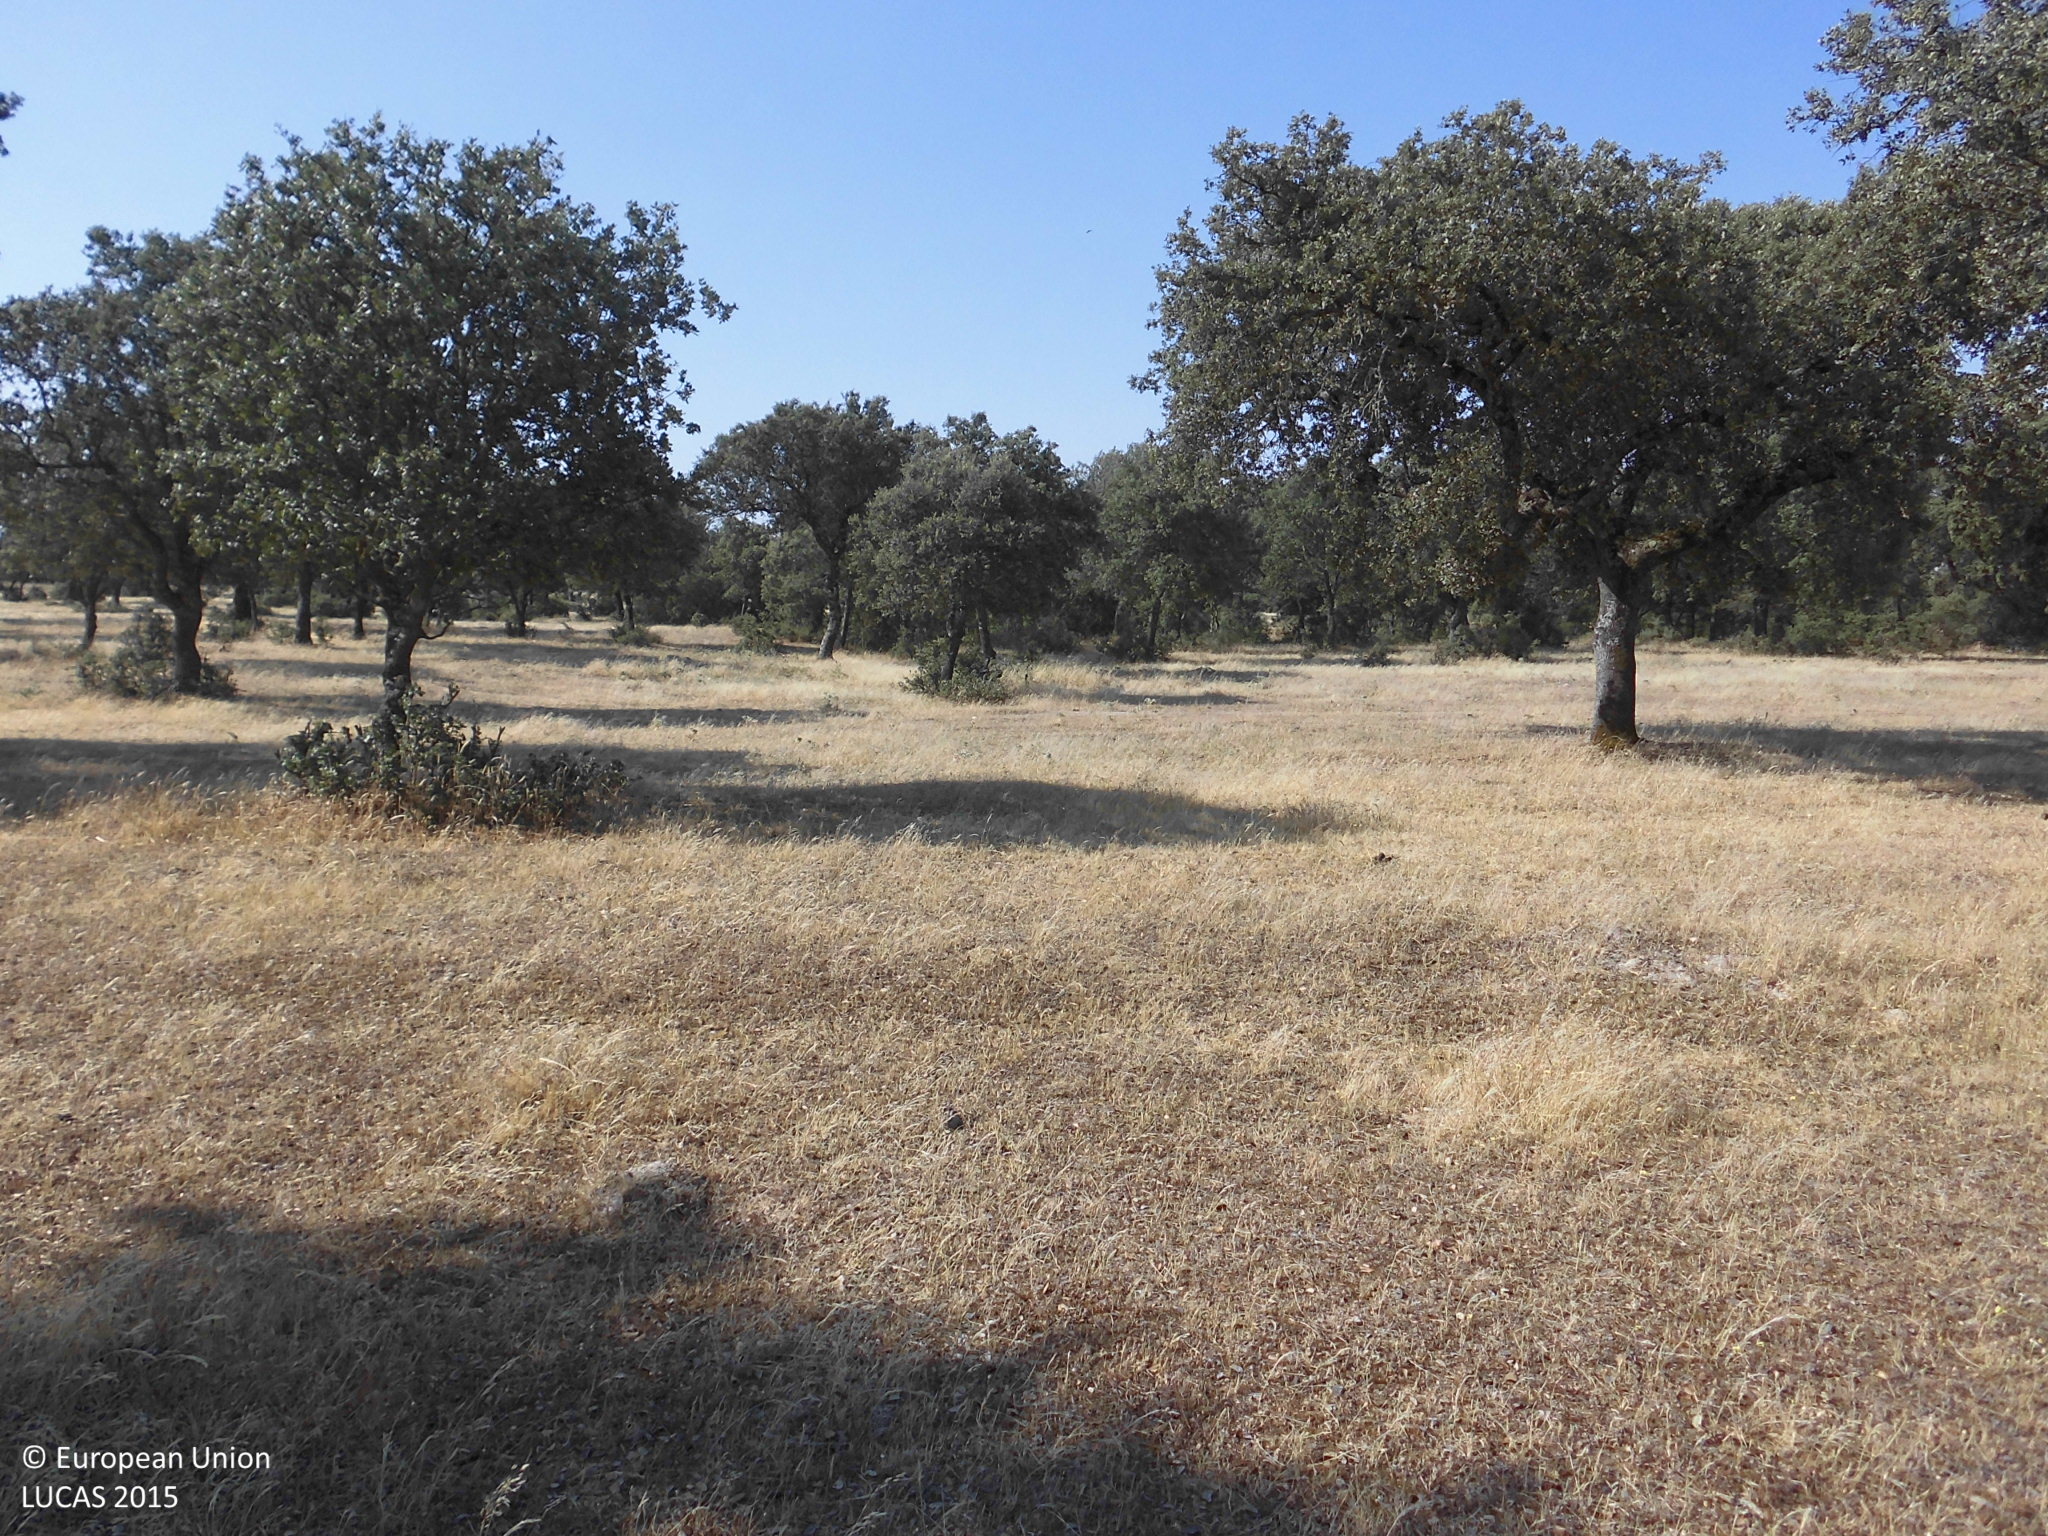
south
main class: Woodland
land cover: Broadleaved woodland
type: broadleaved evergreen forest
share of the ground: 10 - 25 %
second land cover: Grassland without tree/shrub cover
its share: > 75 %
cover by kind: herbaceous plants 85 %, broadleaved forest trees 15 %
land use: Forestry
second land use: Agriculture (excluding fallow land and kitchen gardens)
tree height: > 5 m
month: June
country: ES
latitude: 39.9468
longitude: -5.4967
